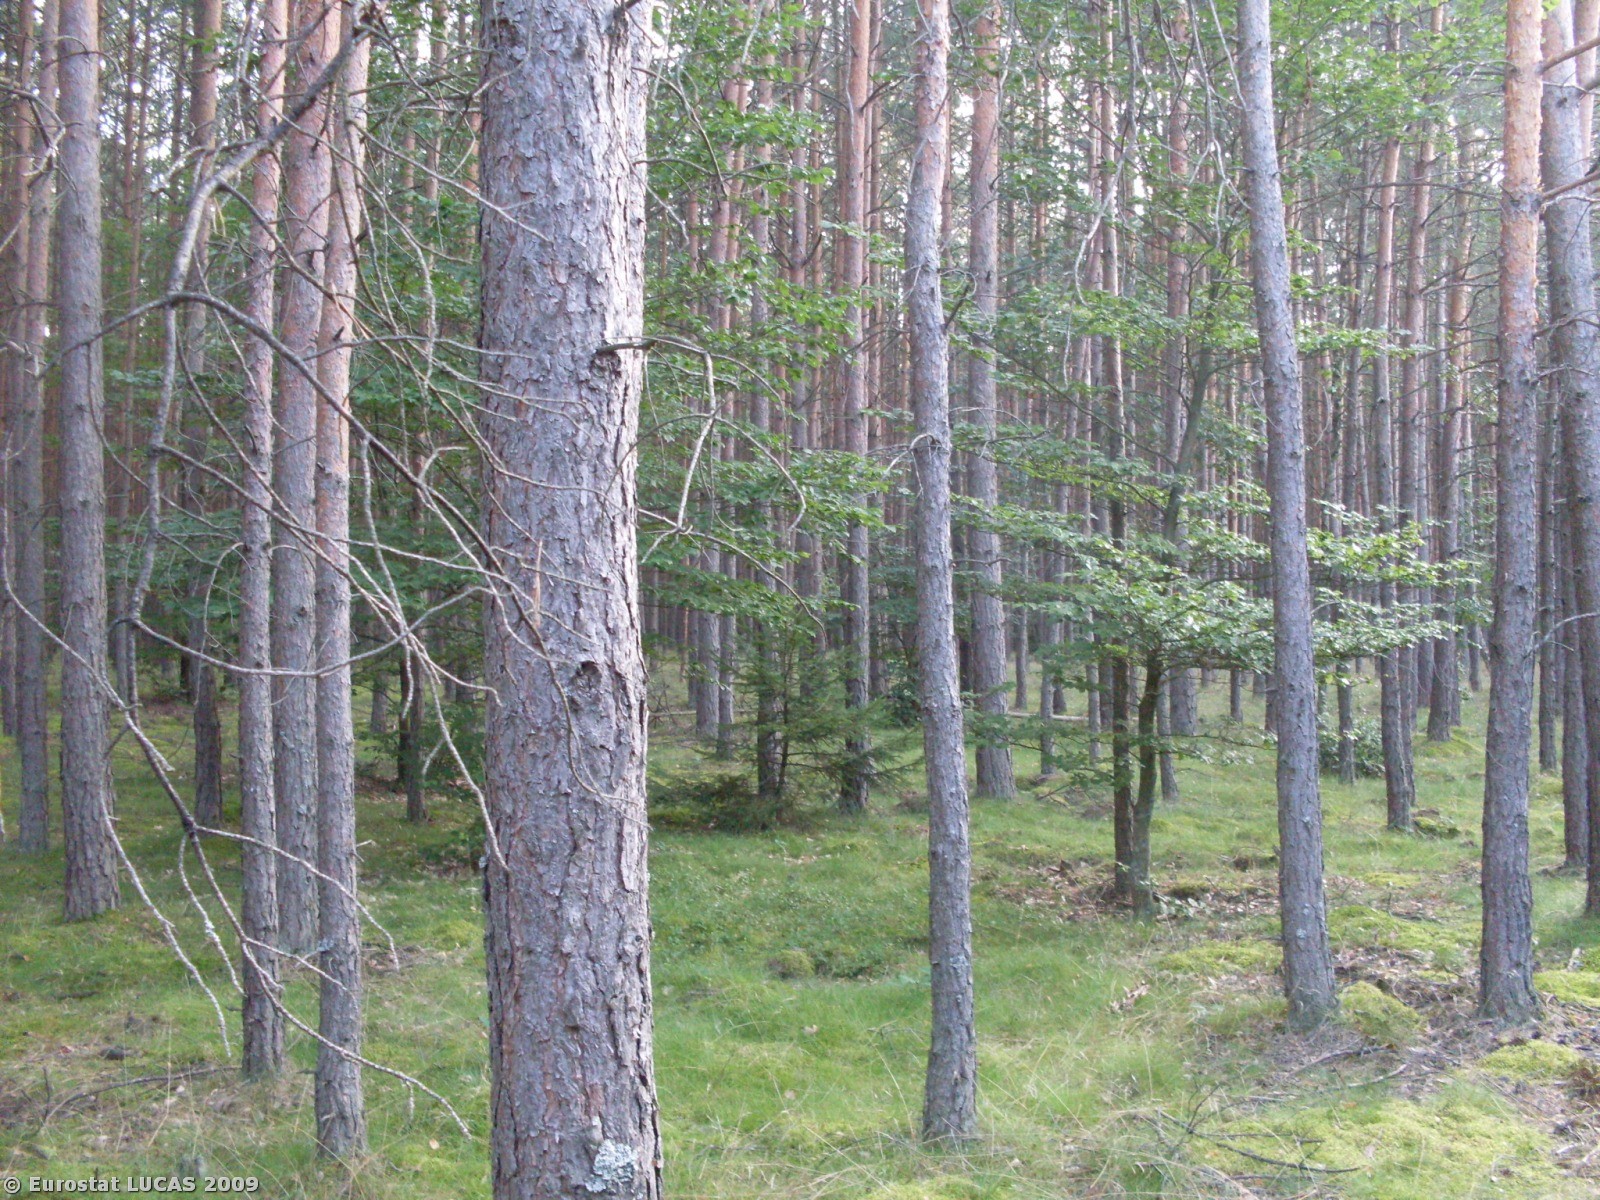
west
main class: Woodland
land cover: Coniferous woodland
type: hemiboreal forest and nemoral coniferous forest and mixed broadleaved-coniferous forest
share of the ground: > 75 %
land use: Forestry
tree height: > 5 m
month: August
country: PL
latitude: 53.0943
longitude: 15.9334
